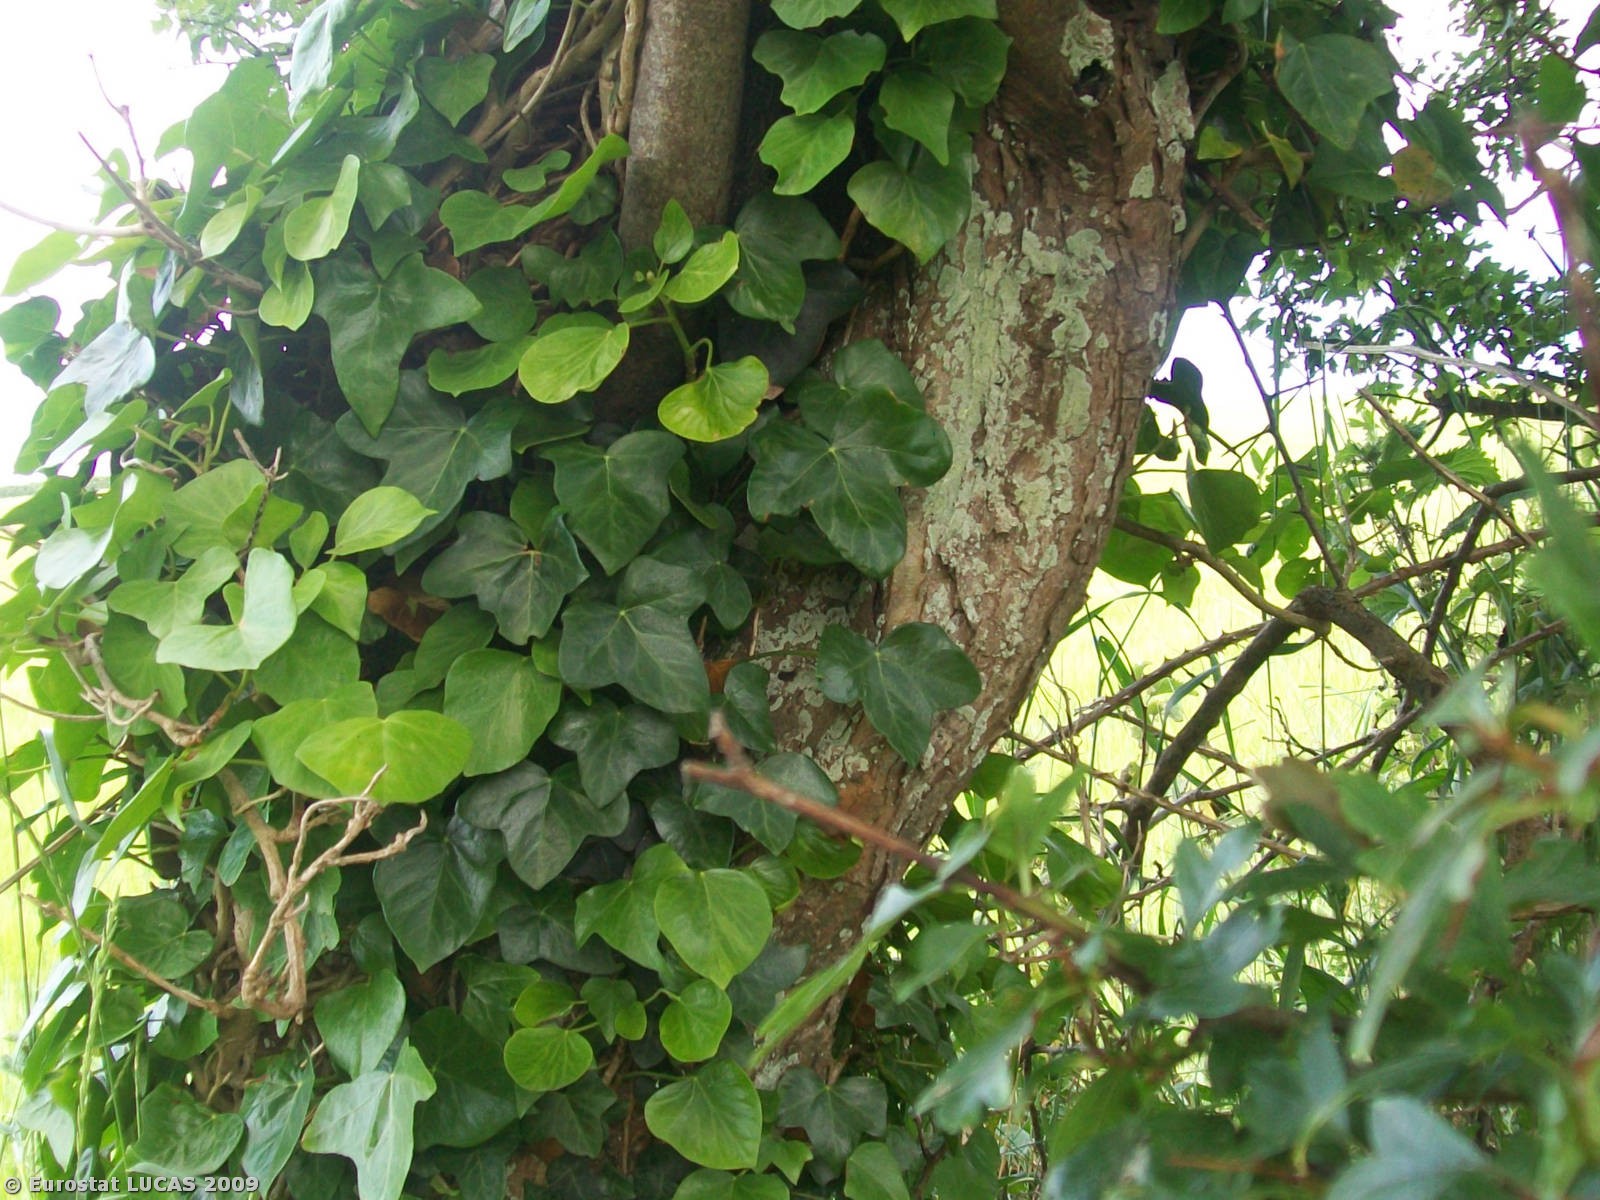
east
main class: Cropland
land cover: Barley
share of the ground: > 75 %
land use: Agriculture (excluding fallow land and kitchen gardens)
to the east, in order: Barley; Managed hedges; Barley
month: July
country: GB
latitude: 50.3370
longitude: -5.1383
